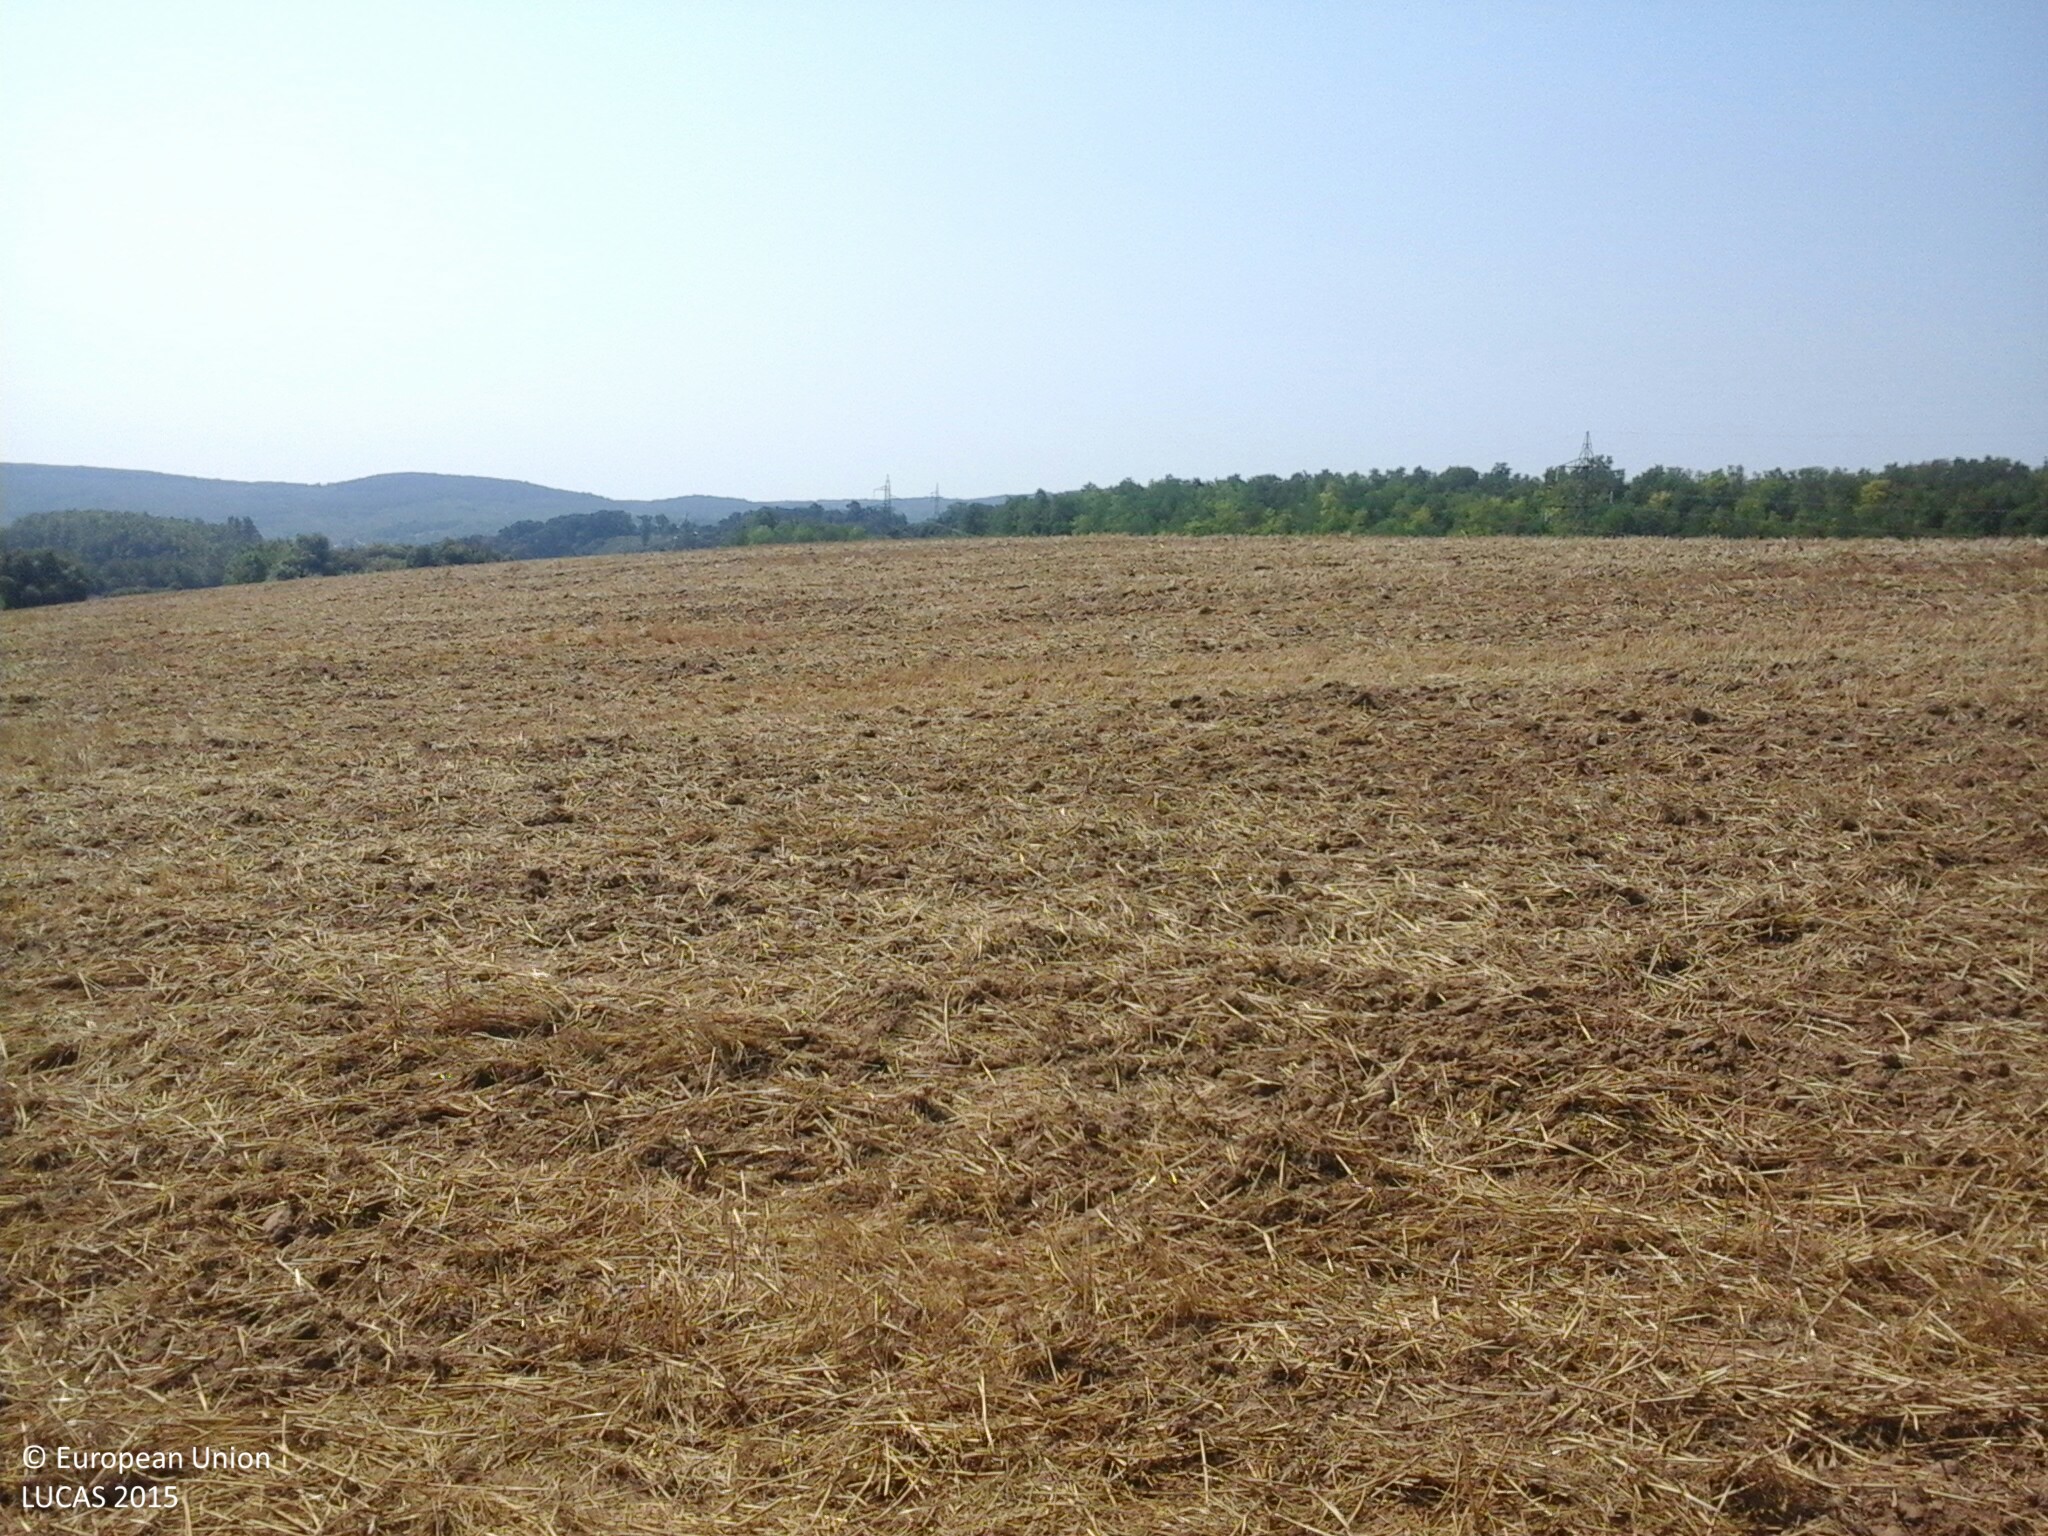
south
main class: Cropland
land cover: Common wheat
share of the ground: 10 - 25 %
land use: Agriculture (excluding fallow land and kitchen gardens)
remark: Harvested field
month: August
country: HU
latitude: 47.3406
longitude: 18.1775
